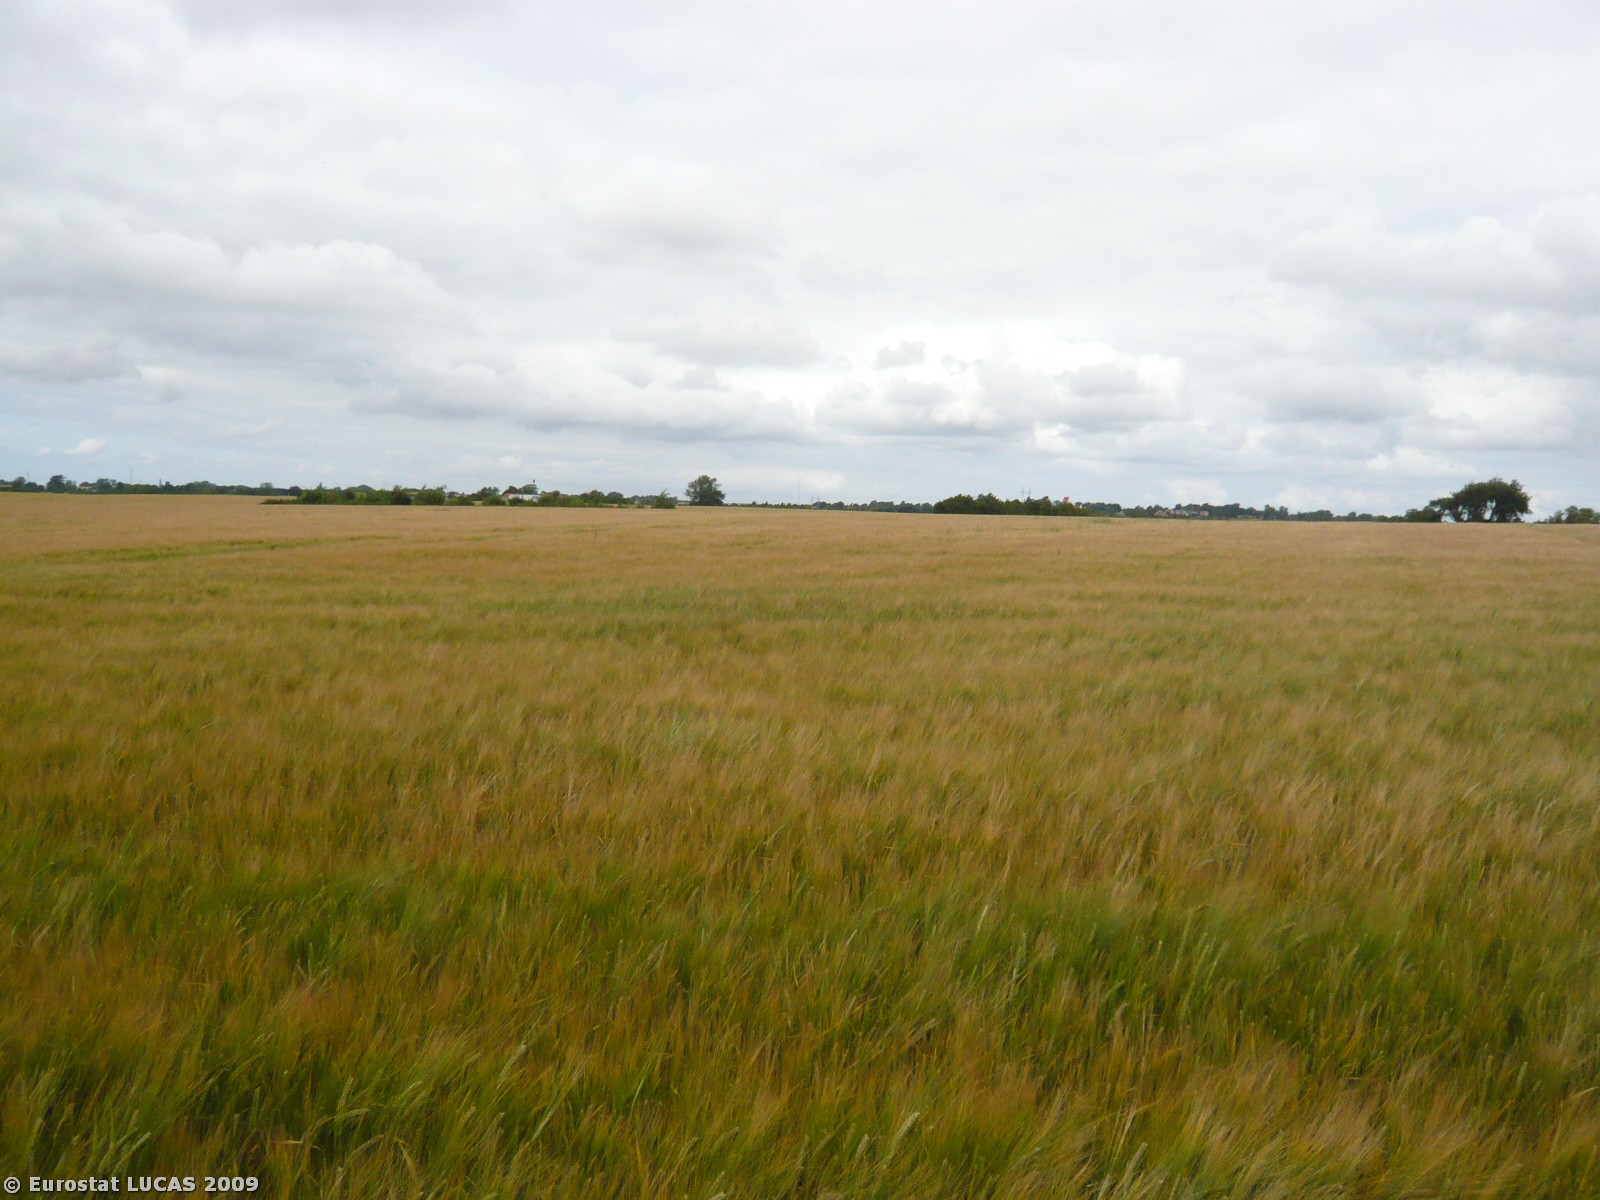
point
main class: Cropland
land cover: Barley
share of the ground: > 75 %
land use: Agriculture (excluding fallow land and kitchen gardens)
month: July
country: DK
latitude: 55.6067
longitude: 11.2211
